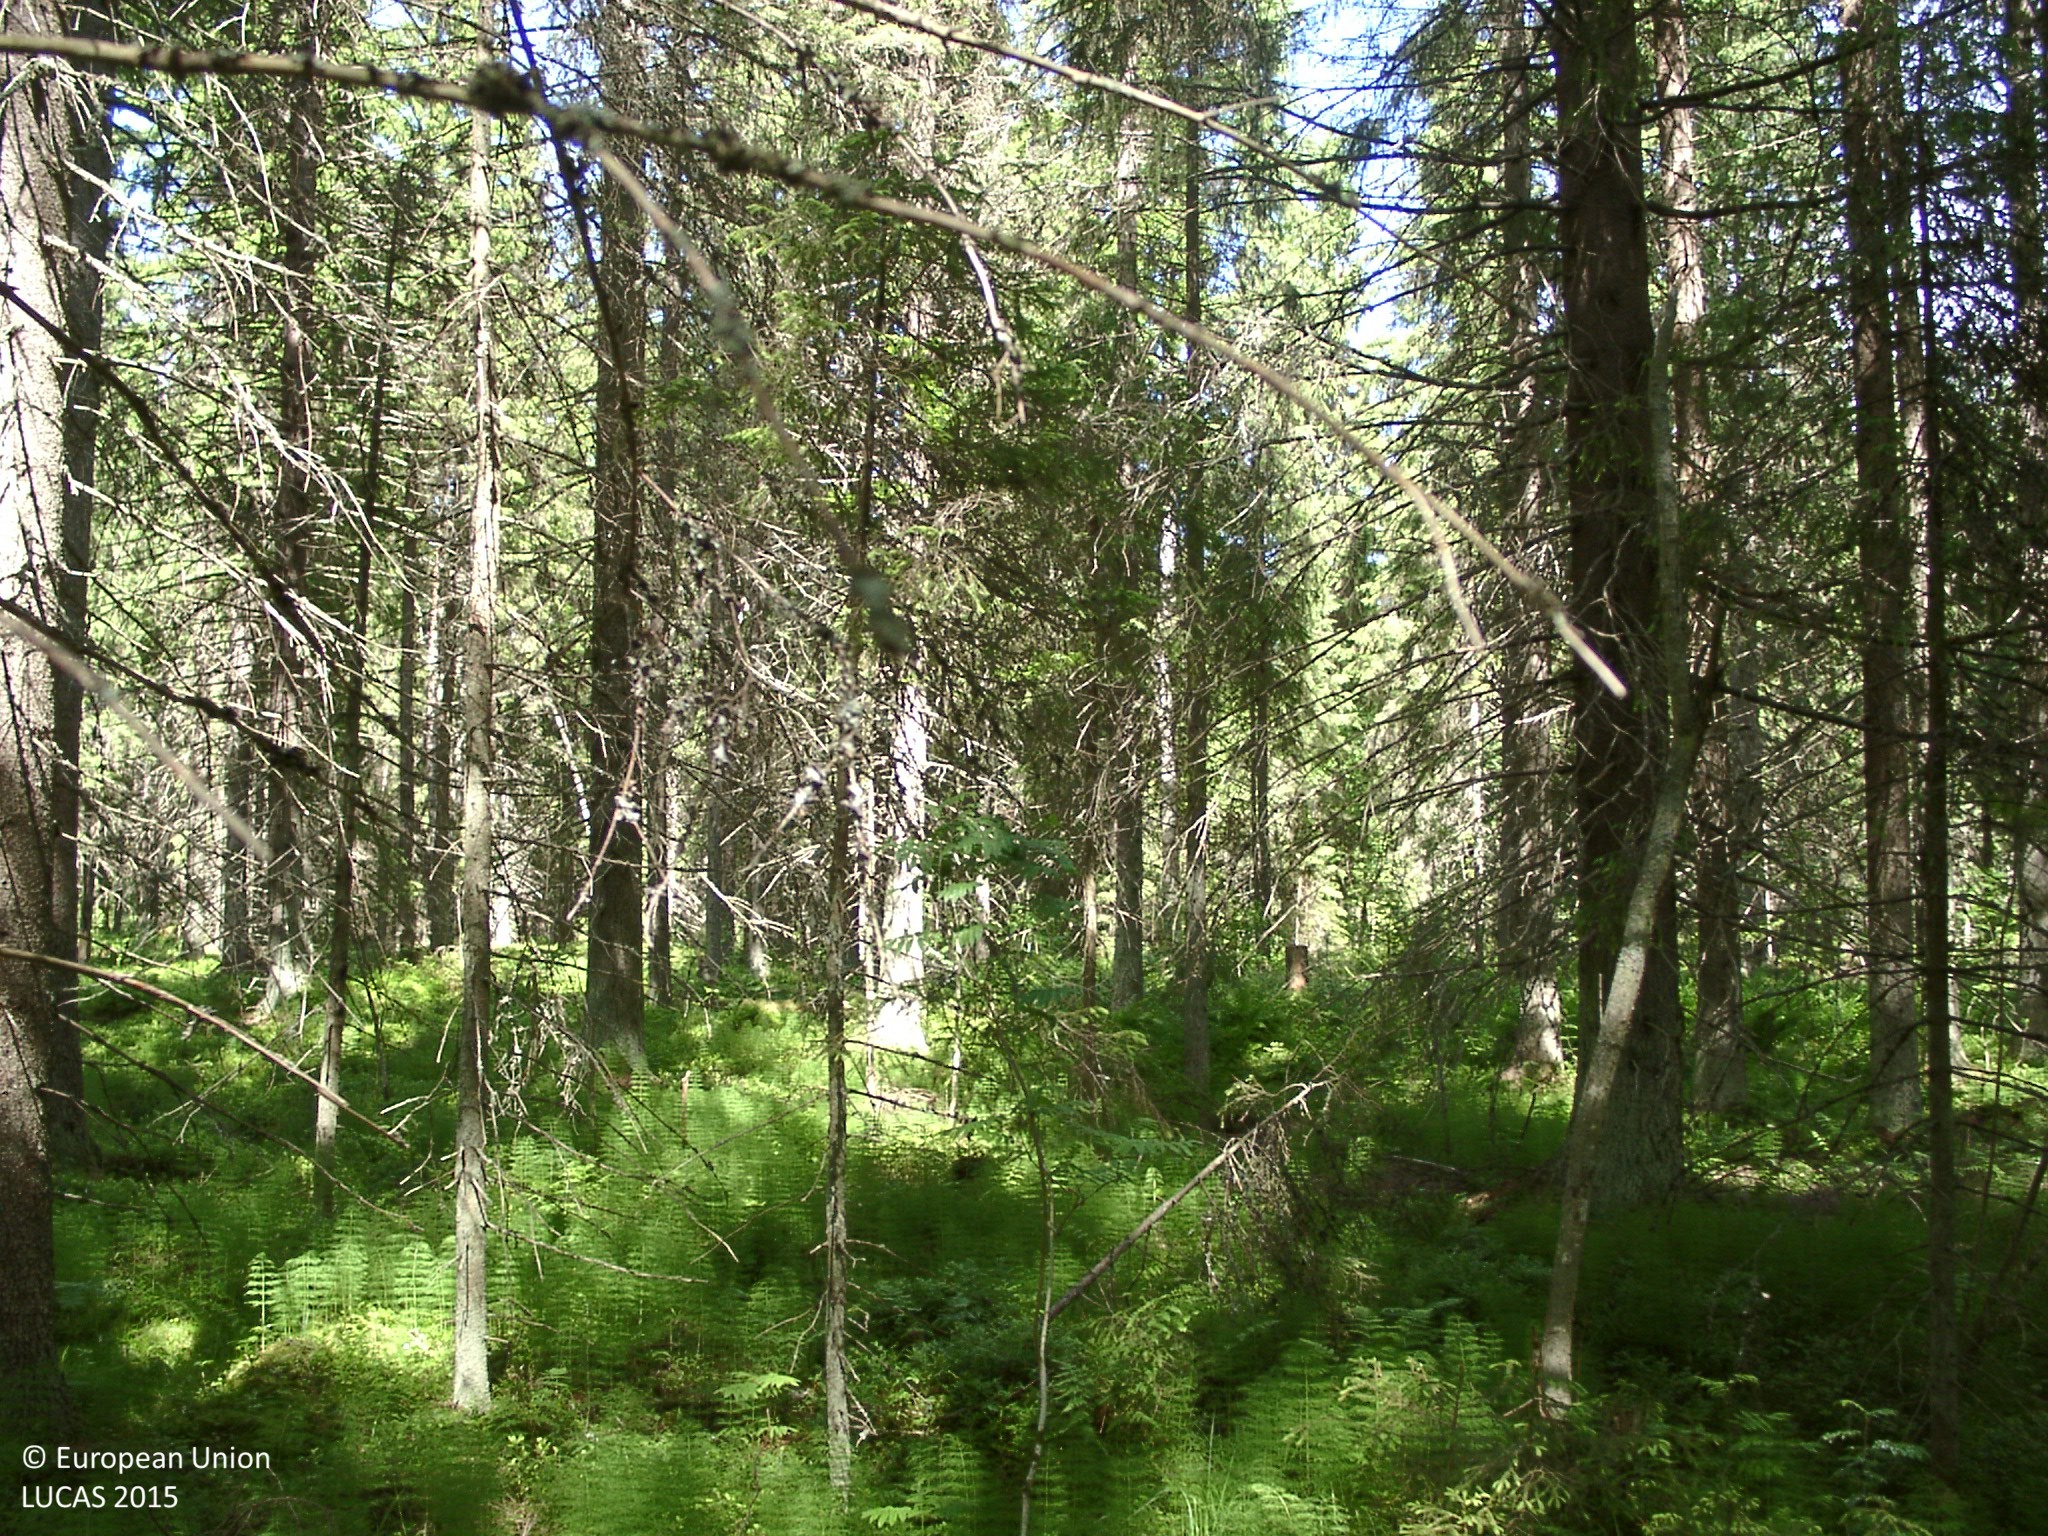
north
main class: Woodland
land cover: Spruce dominated coniferous woodland
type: boreal forest
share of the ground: 50 - 75 %
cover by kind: coniferous forest trees 70 %, shrubs 15 %, herbaceous plants 10 %, lichens and mosses 5 %
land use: Forestry
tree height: > 5 m
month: June
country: FI
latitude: 62.1633
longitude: 24.8626
